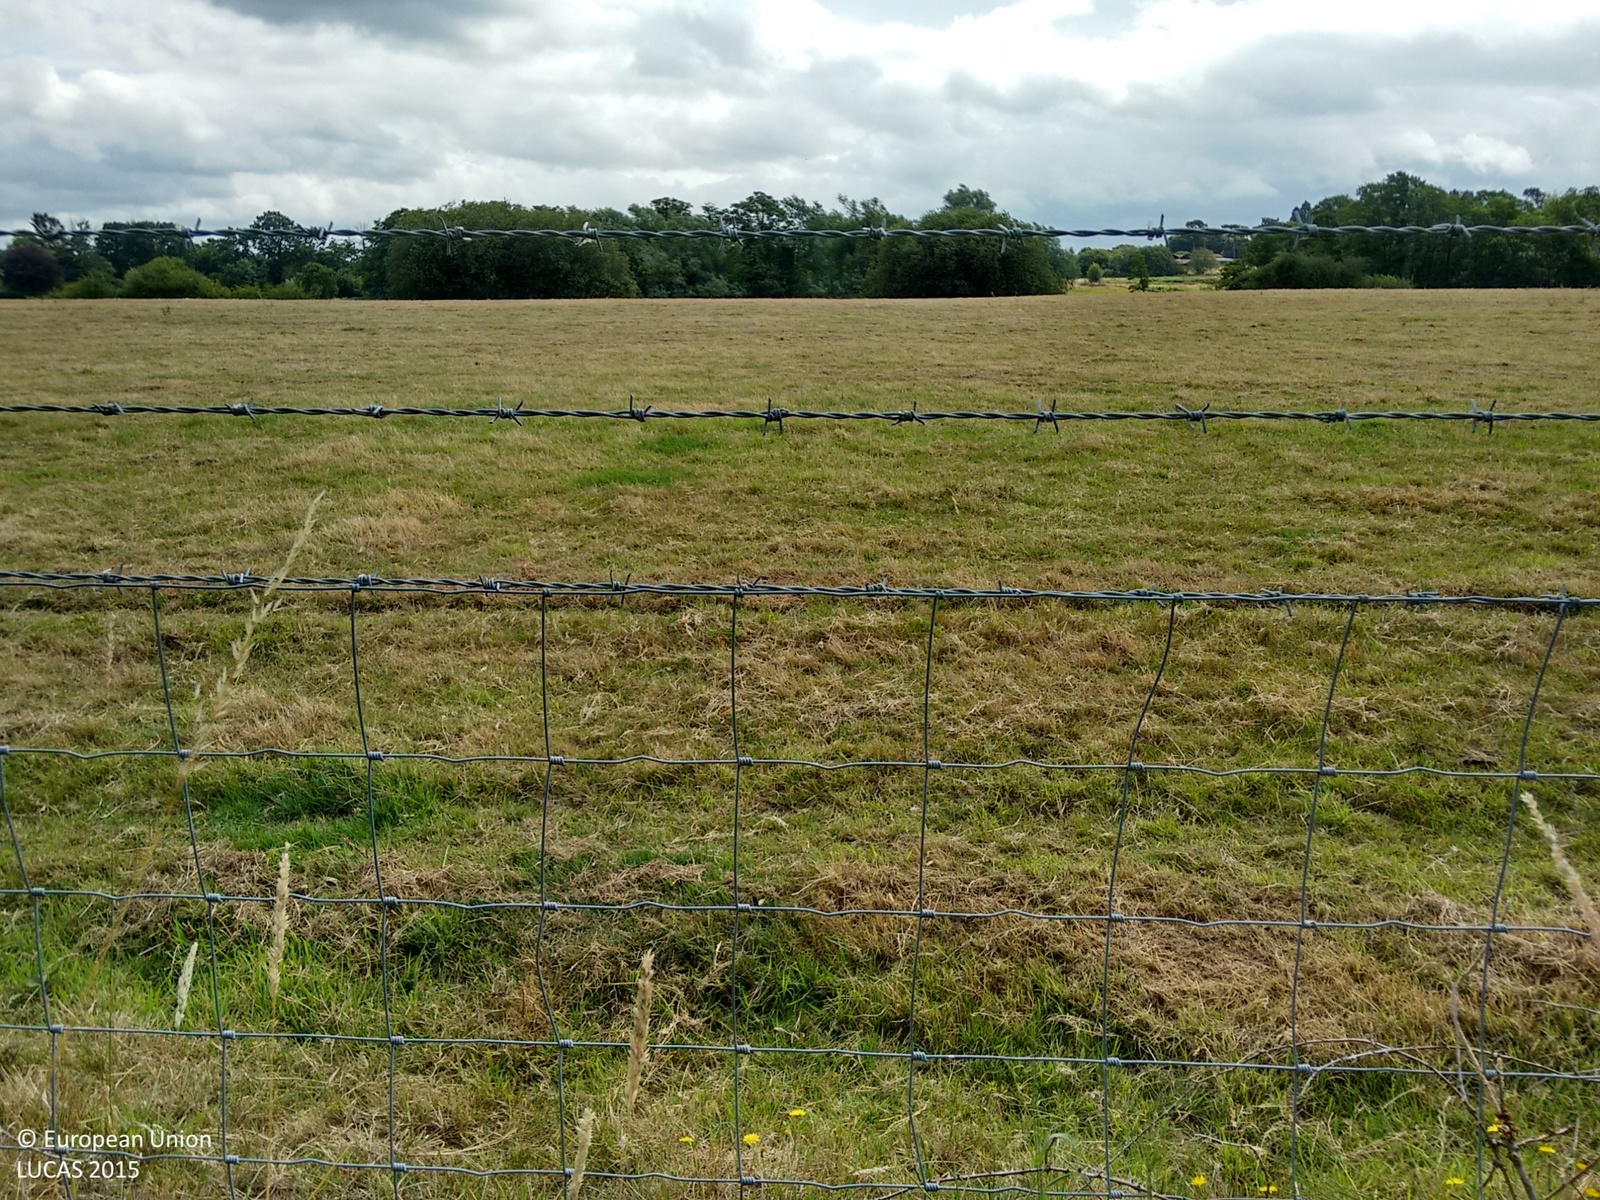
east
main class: Grassland
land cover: Grassland without tree/shrub cover
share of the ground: > 75 %
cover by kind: herbaceous plants 100 %
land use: Agriculture (excluding fallow land and kitchen gardens)
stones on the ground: < 10 %
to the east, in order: Grassland without tree/shrub cover; Abandoned hedges; Tracks; Managed hedges; Grassland without tree/shrub cover; Fences; Grassland without tree/shrub cover
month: July
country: GB
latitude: 51.2894
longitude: -0.5497
